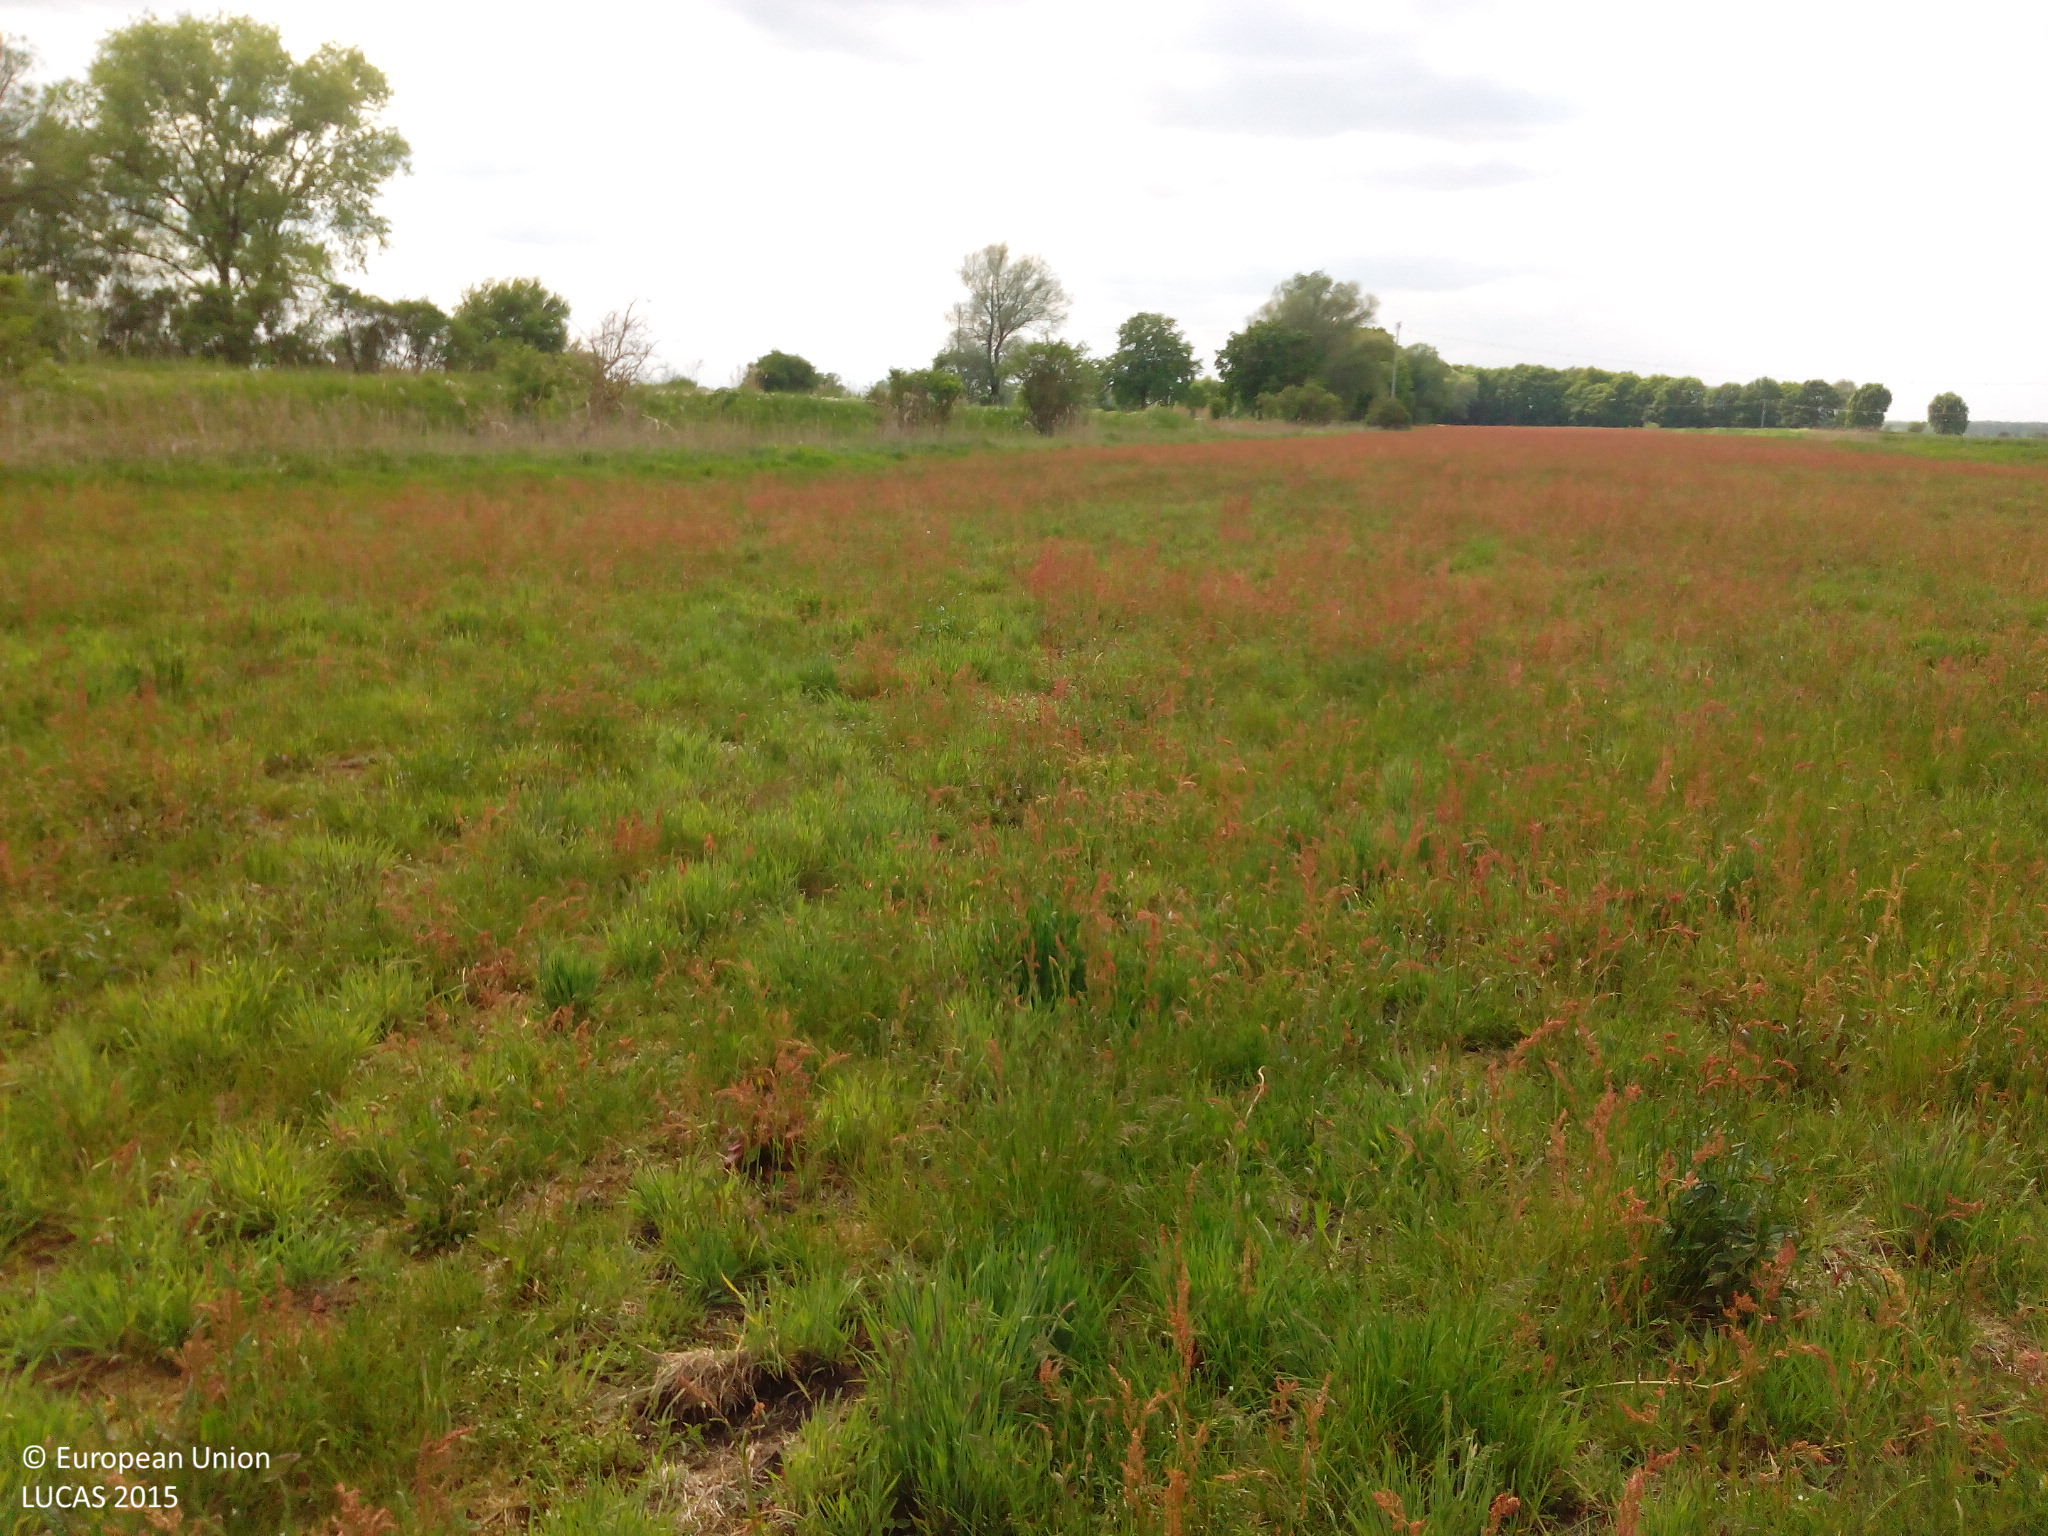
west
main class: Grassland
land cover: Grassland without tree/shrub cover
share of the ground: > 75 %
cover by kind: herbaceous plants 100 %
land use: Agriculture (excluding fallow land and kitchen gardens)
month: May
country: DE
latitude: 53.4627
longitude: 11.6411
